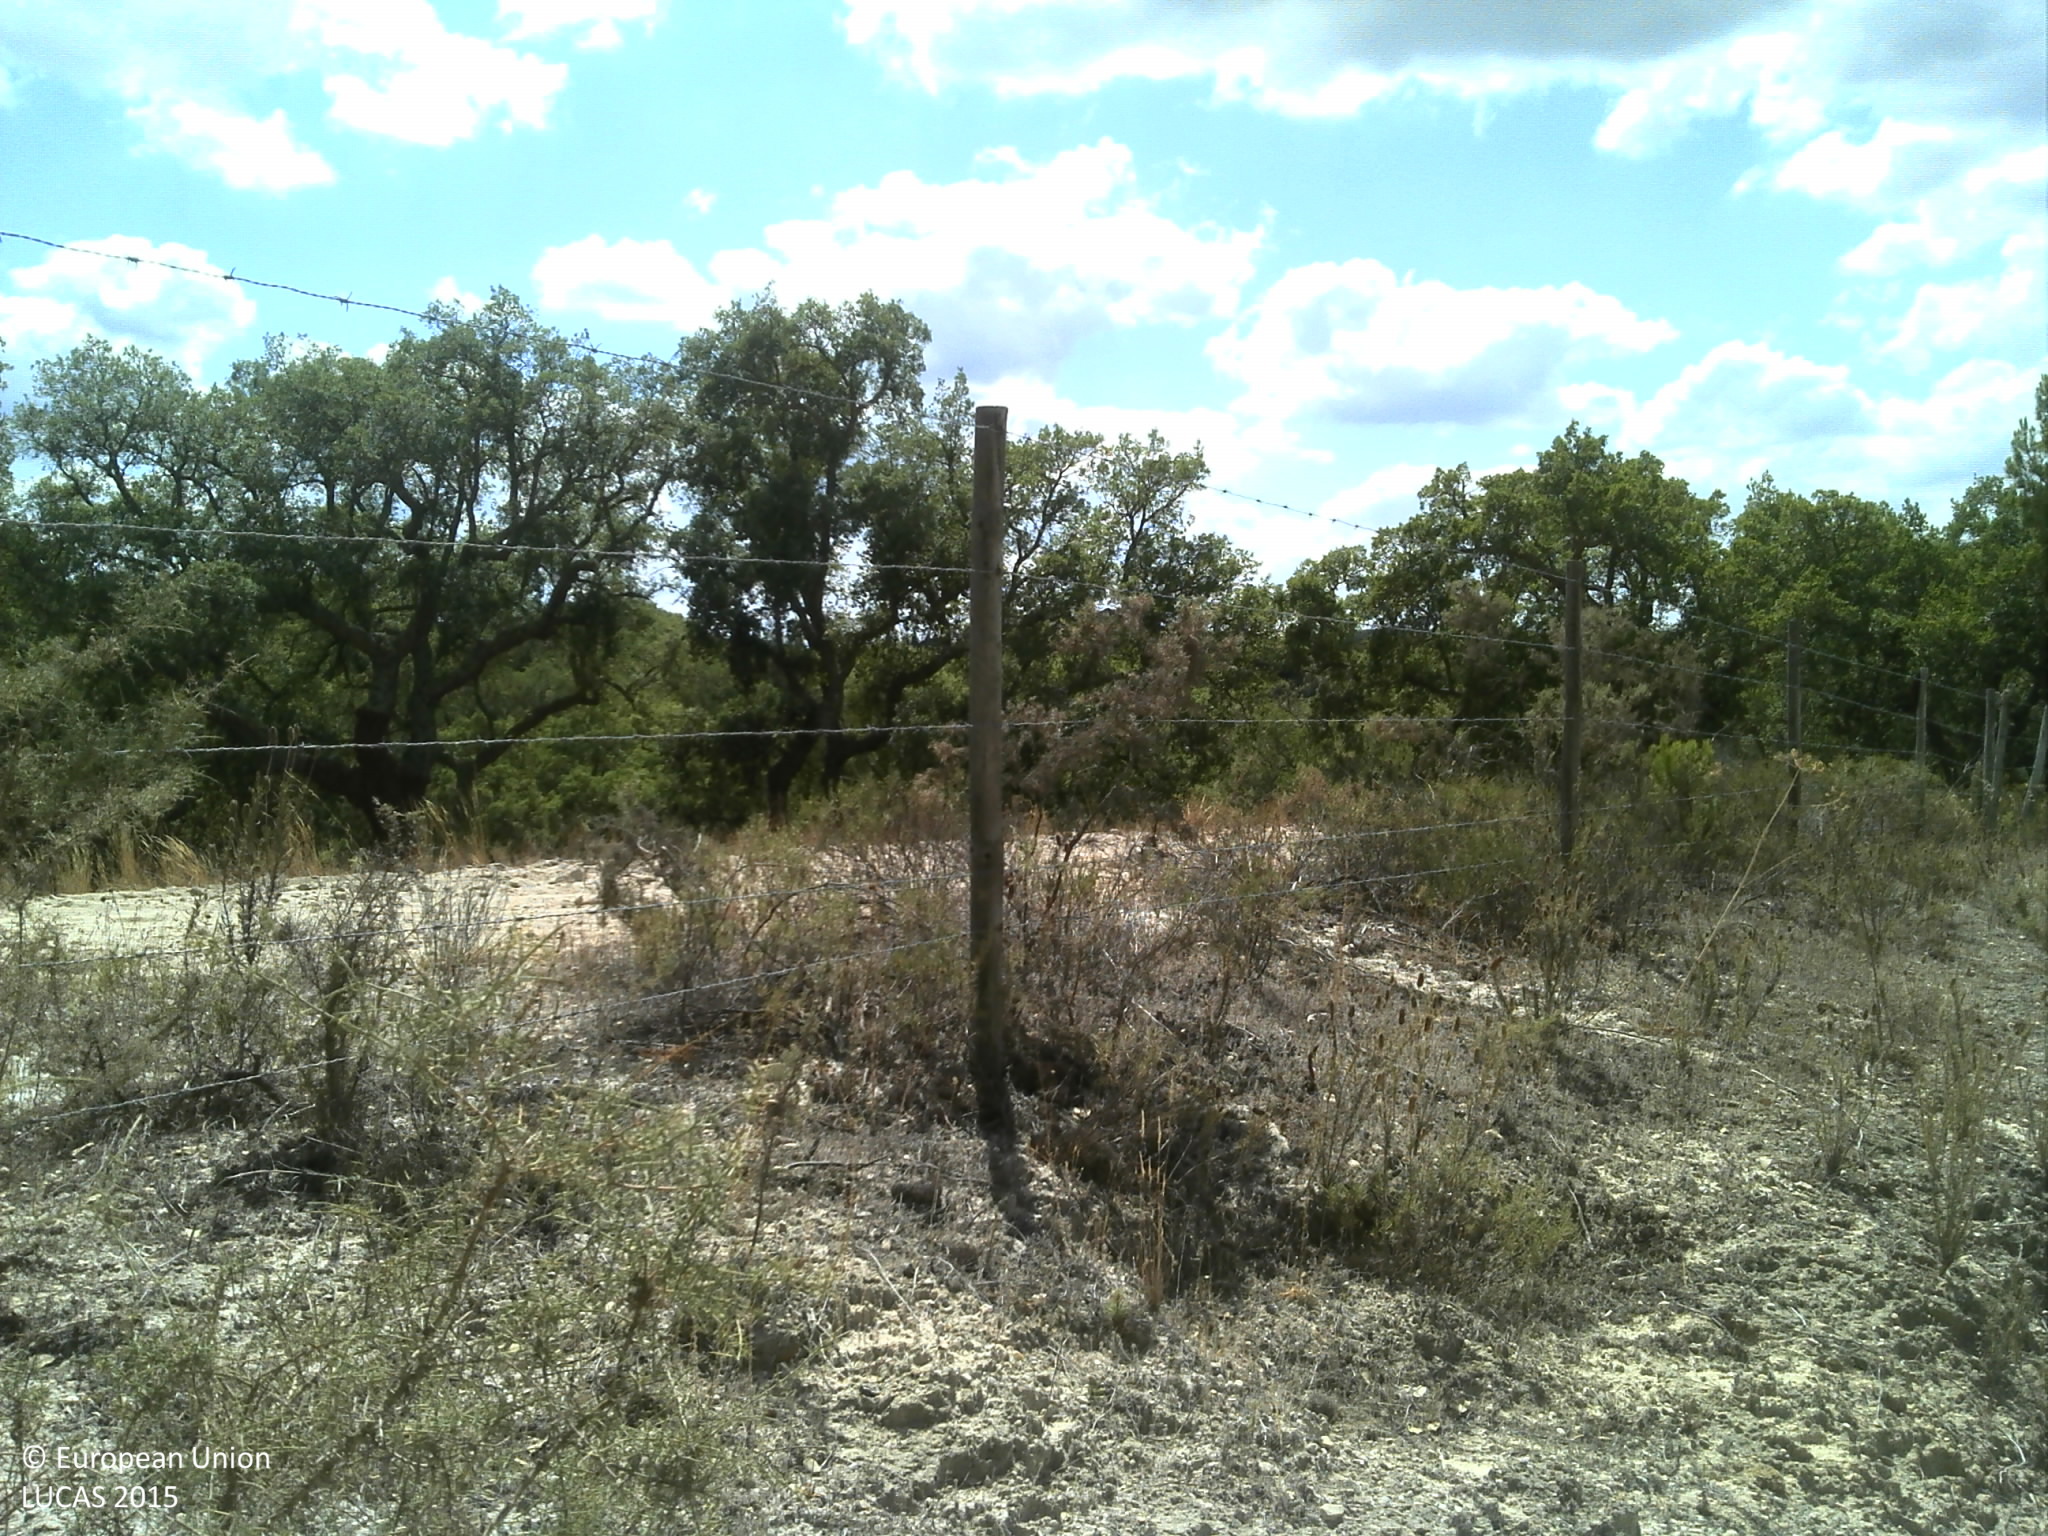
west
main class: Woodland
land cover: Broadleaved woodland
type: broadleaved evergreen forest
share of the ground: 50 - 75 %
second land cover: Grassland without tree/shrub cover
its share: 25 - 50 %
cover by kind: broadleaved forest trees 50 %, herbaceous plants 25 %, unconsolidated bare surface 25 %
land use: Forestry
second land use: Agriculture (excluding fallow land and kitchen gardens)
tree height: > 5 m
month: July
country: PT
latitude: 38.9678
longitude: -8.2330
